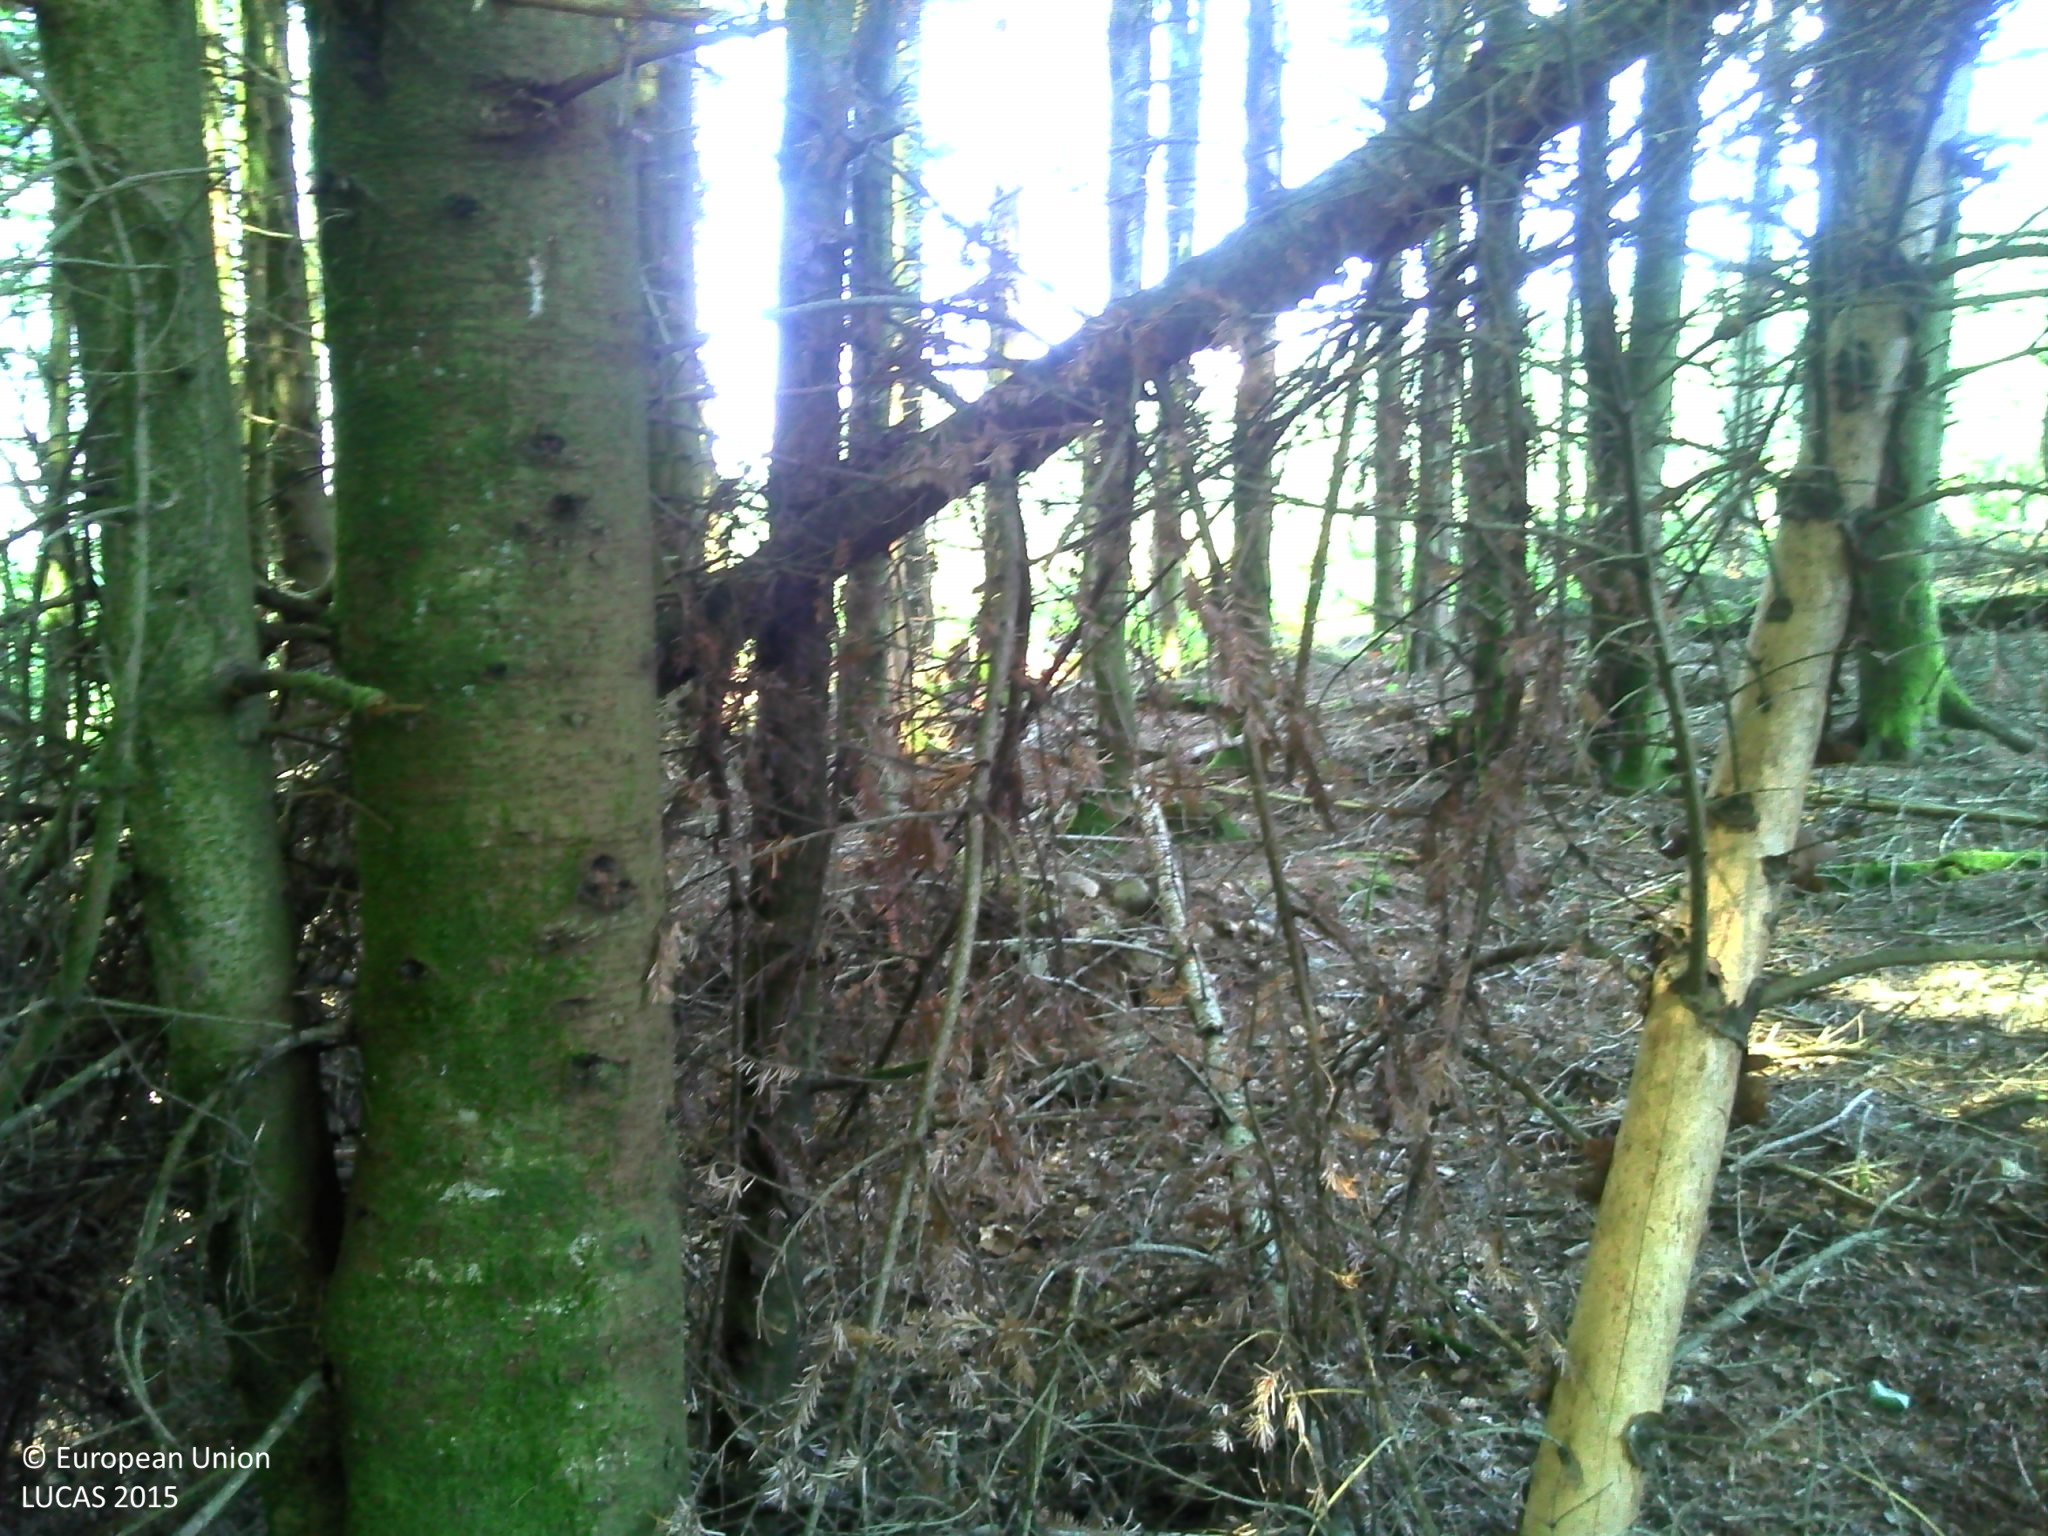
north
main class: Woodland
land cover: Spruce dominated coniferous woodland
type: hemiboreal forest and nemoral coniferous forest and mixed broadleaved-coniferous forest
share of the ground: > 75 %
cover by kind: coniferous forest trees 80 %, herbaceous plants 10 %, lichens and mosses 10 %
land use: Forestry
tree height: > 5 m
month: August
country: FR
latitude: 46.1708
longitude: 4.4455
